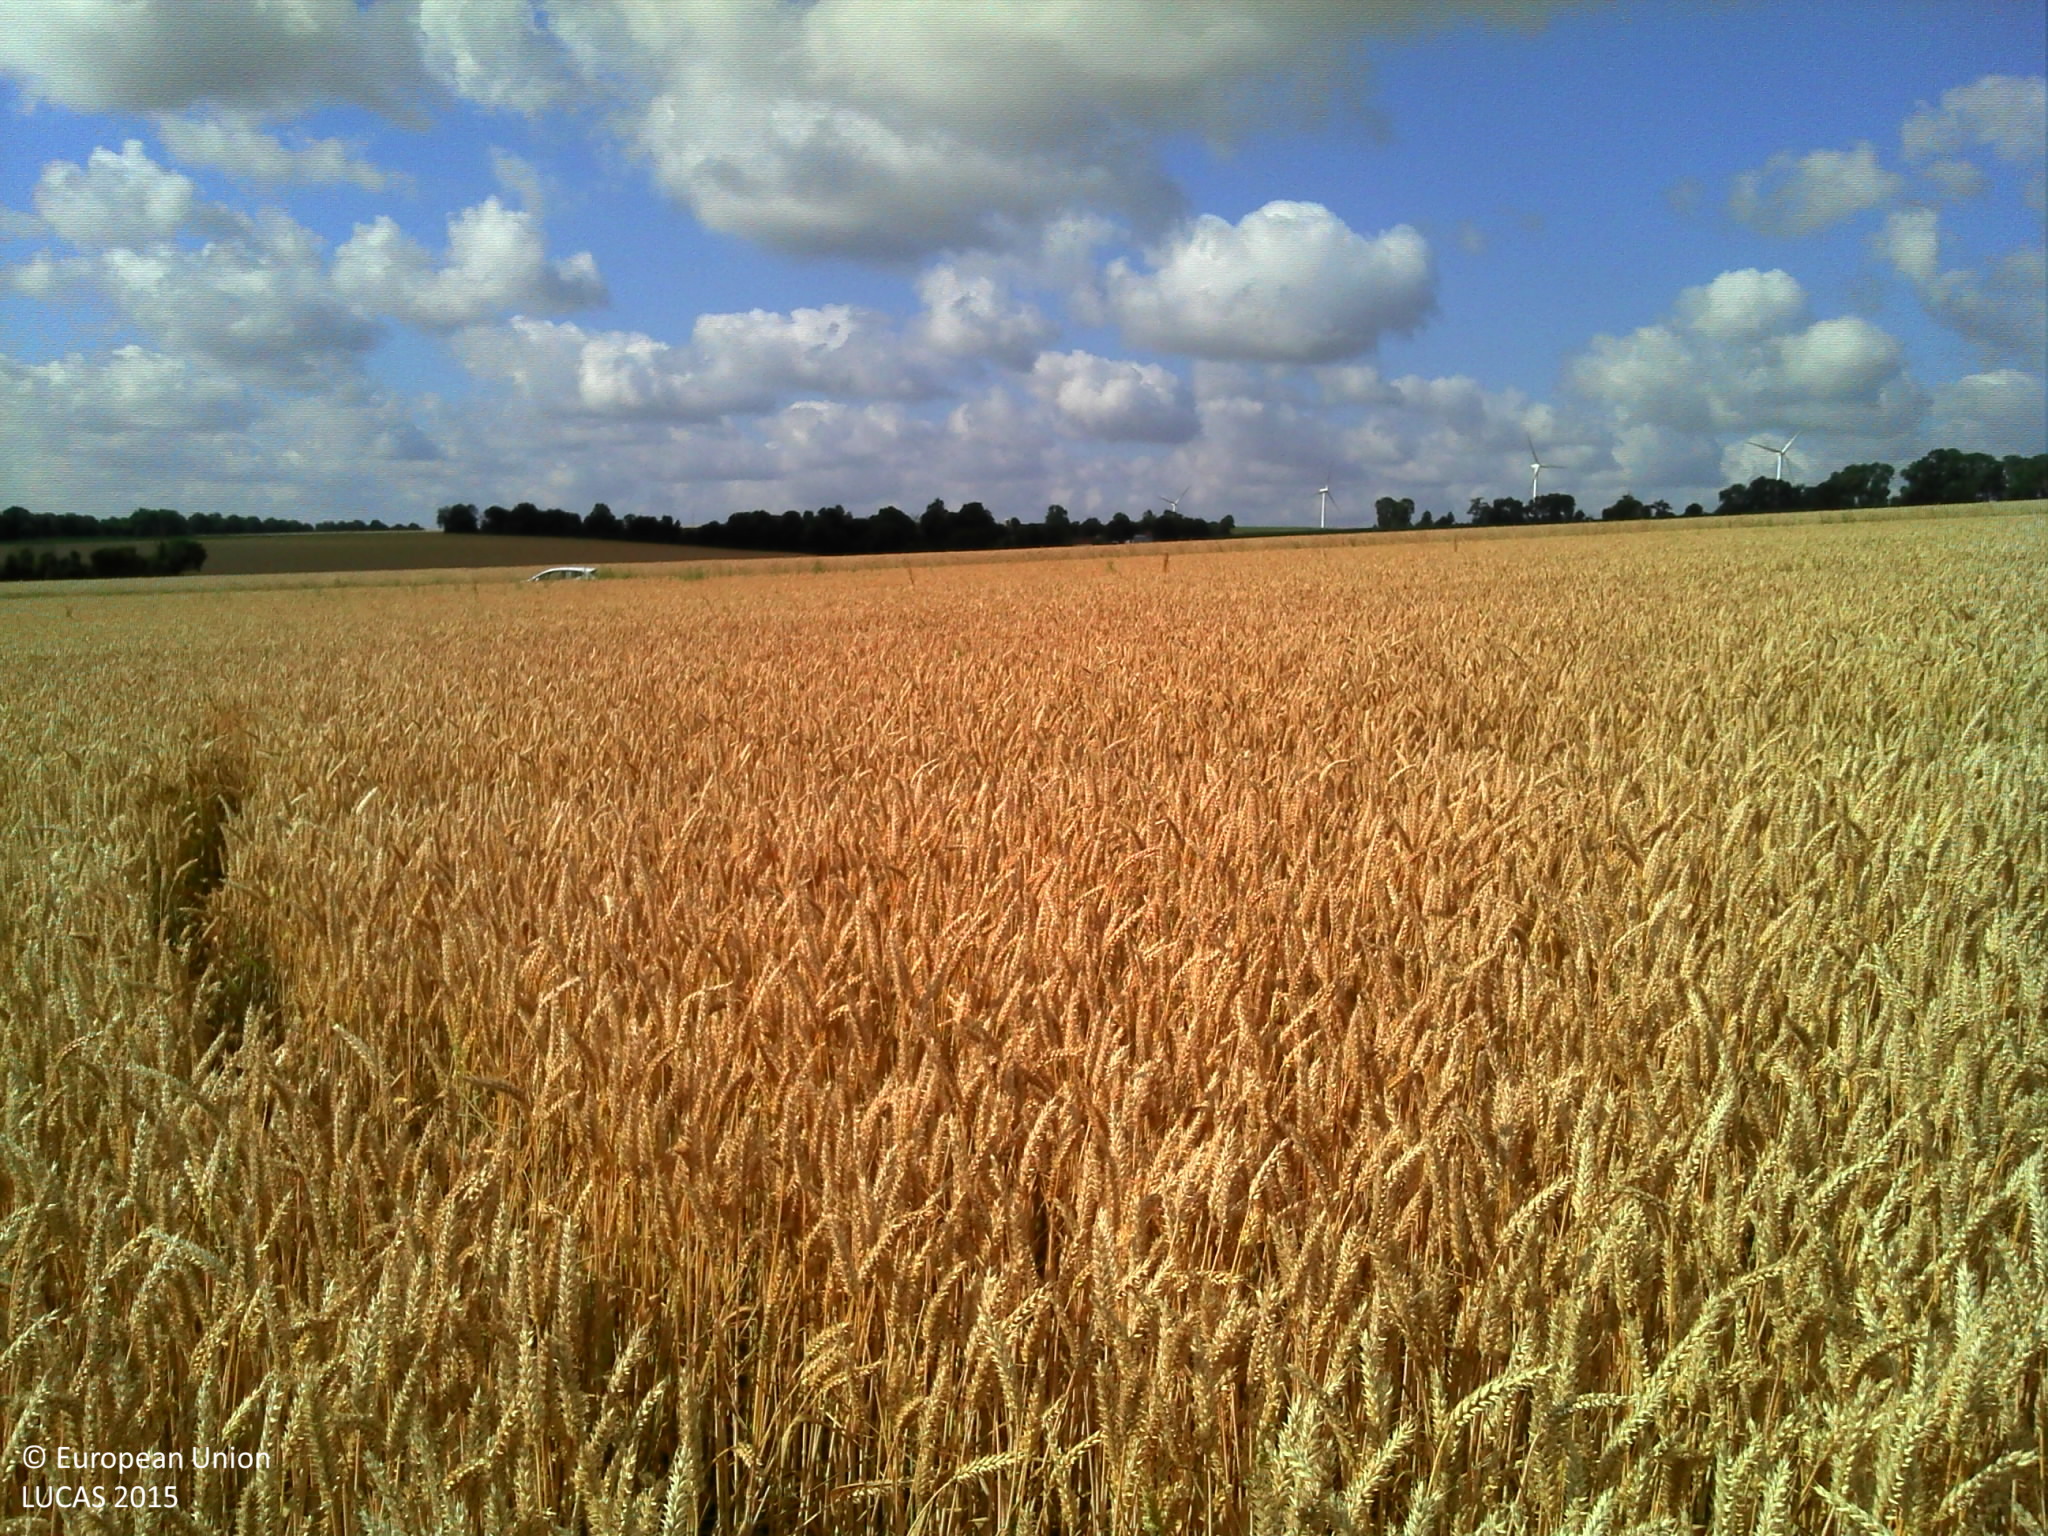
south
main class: Cropland
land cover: Common wheat
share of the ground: > 75 %
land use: Agriculture (excluding fallow land and kitchen gardens)
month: July
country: FR
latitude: 48.9481
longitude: -0.1778
